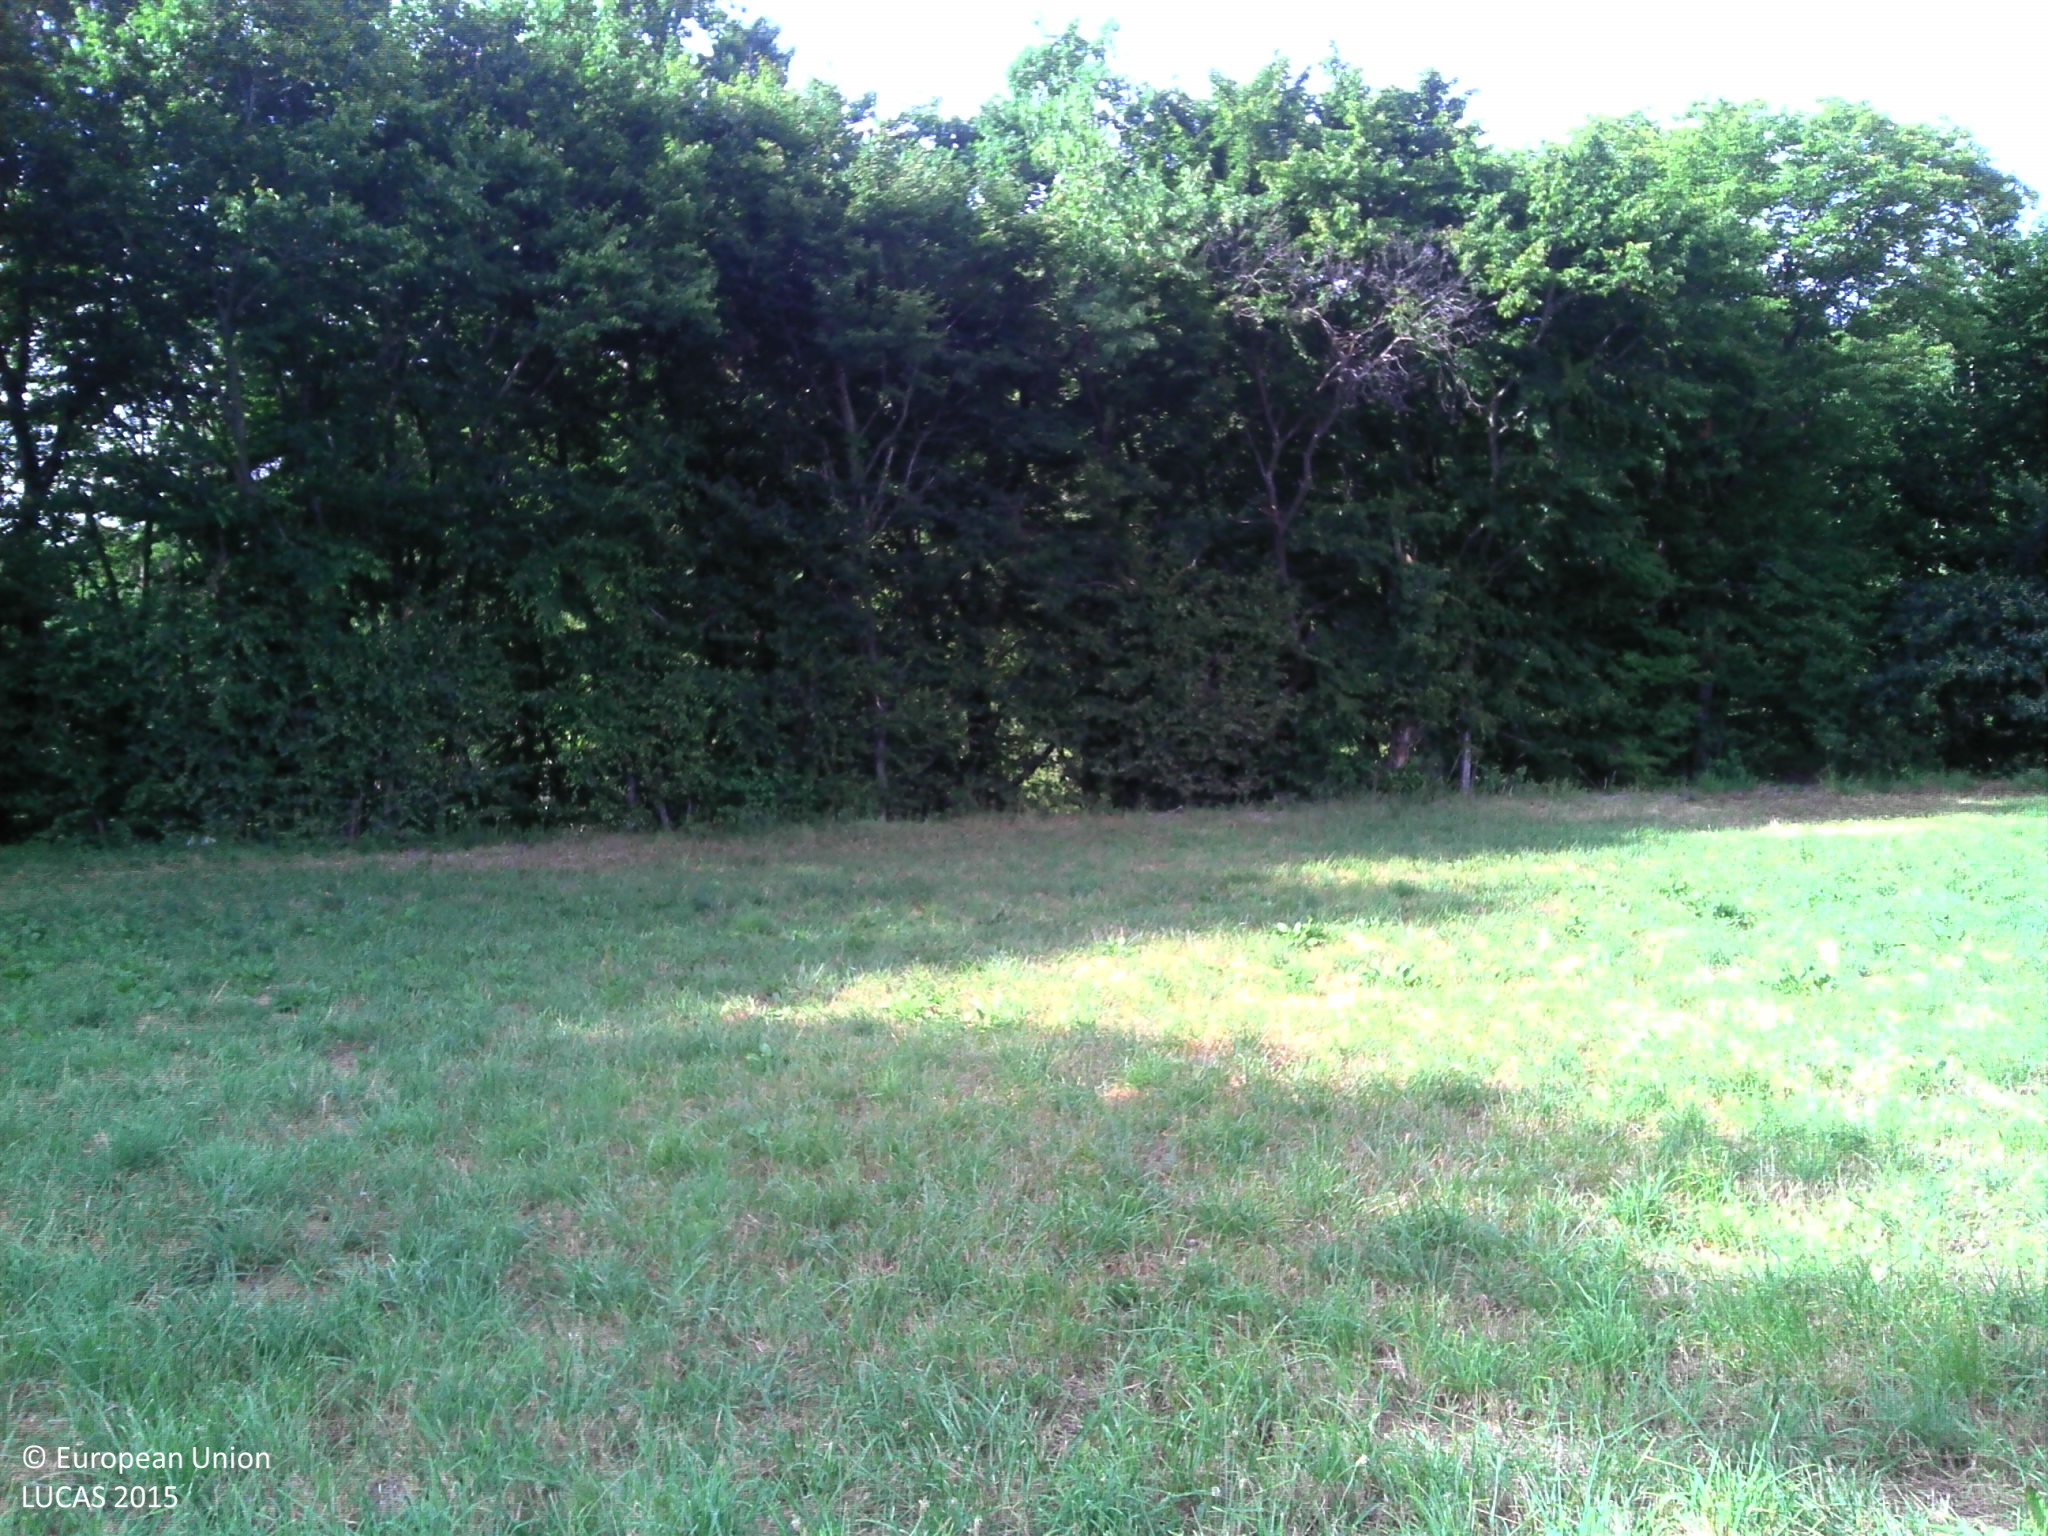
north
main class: Grassland
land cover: Grassland without tree/shrub cover
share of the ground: > 75 %
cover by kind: herbaceous plants 100 %
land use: Agriculture (excluding fallow land and kitchen gardens)
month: July
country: FR
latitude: 45.6028
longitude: 5.4016
